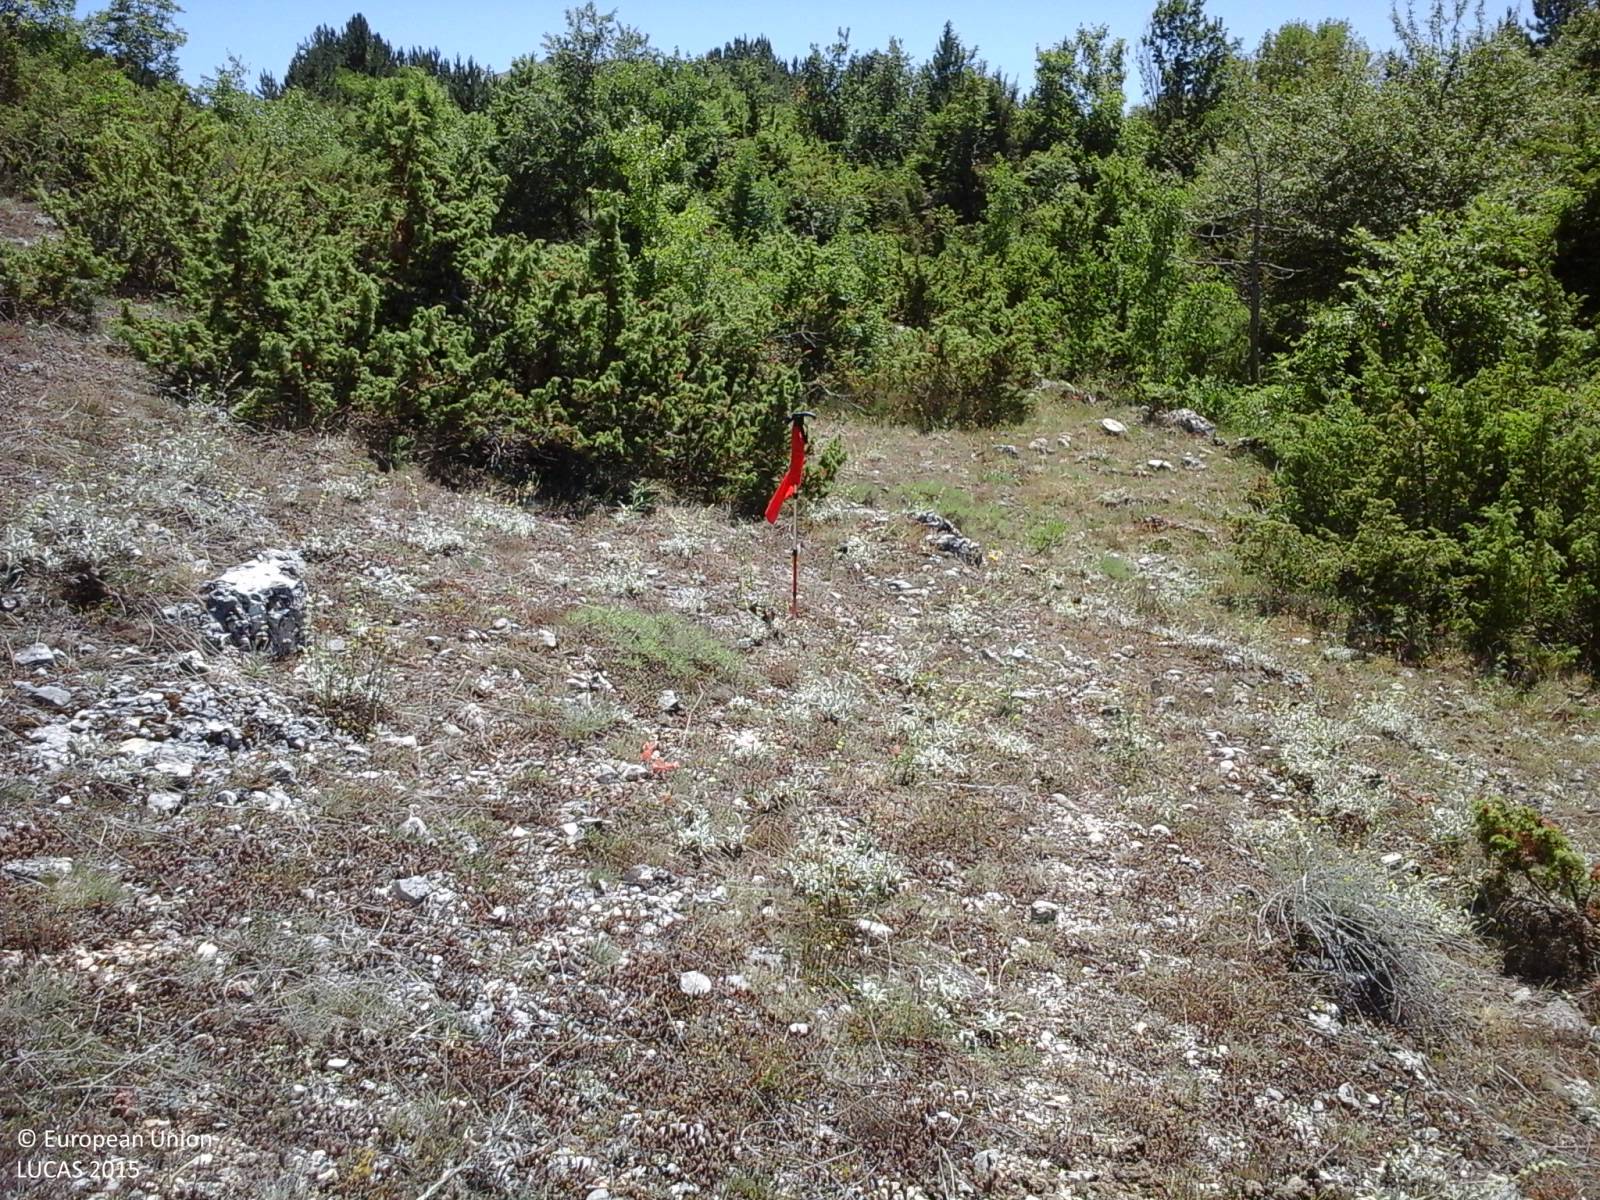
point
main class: Shrubland
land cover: Shrubland with sparse tree cover
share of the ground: > 75 %
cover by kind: herbaceous plants 55 %, shrubs 20 %, unconsolidated bare surface 20 %, broadleaved forest trees 5 %
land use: Agriculture (excluding fallow land and kitchen gardens)
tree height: < 5 m
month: June
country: IT
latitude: 41.9169
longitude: 13.7128
